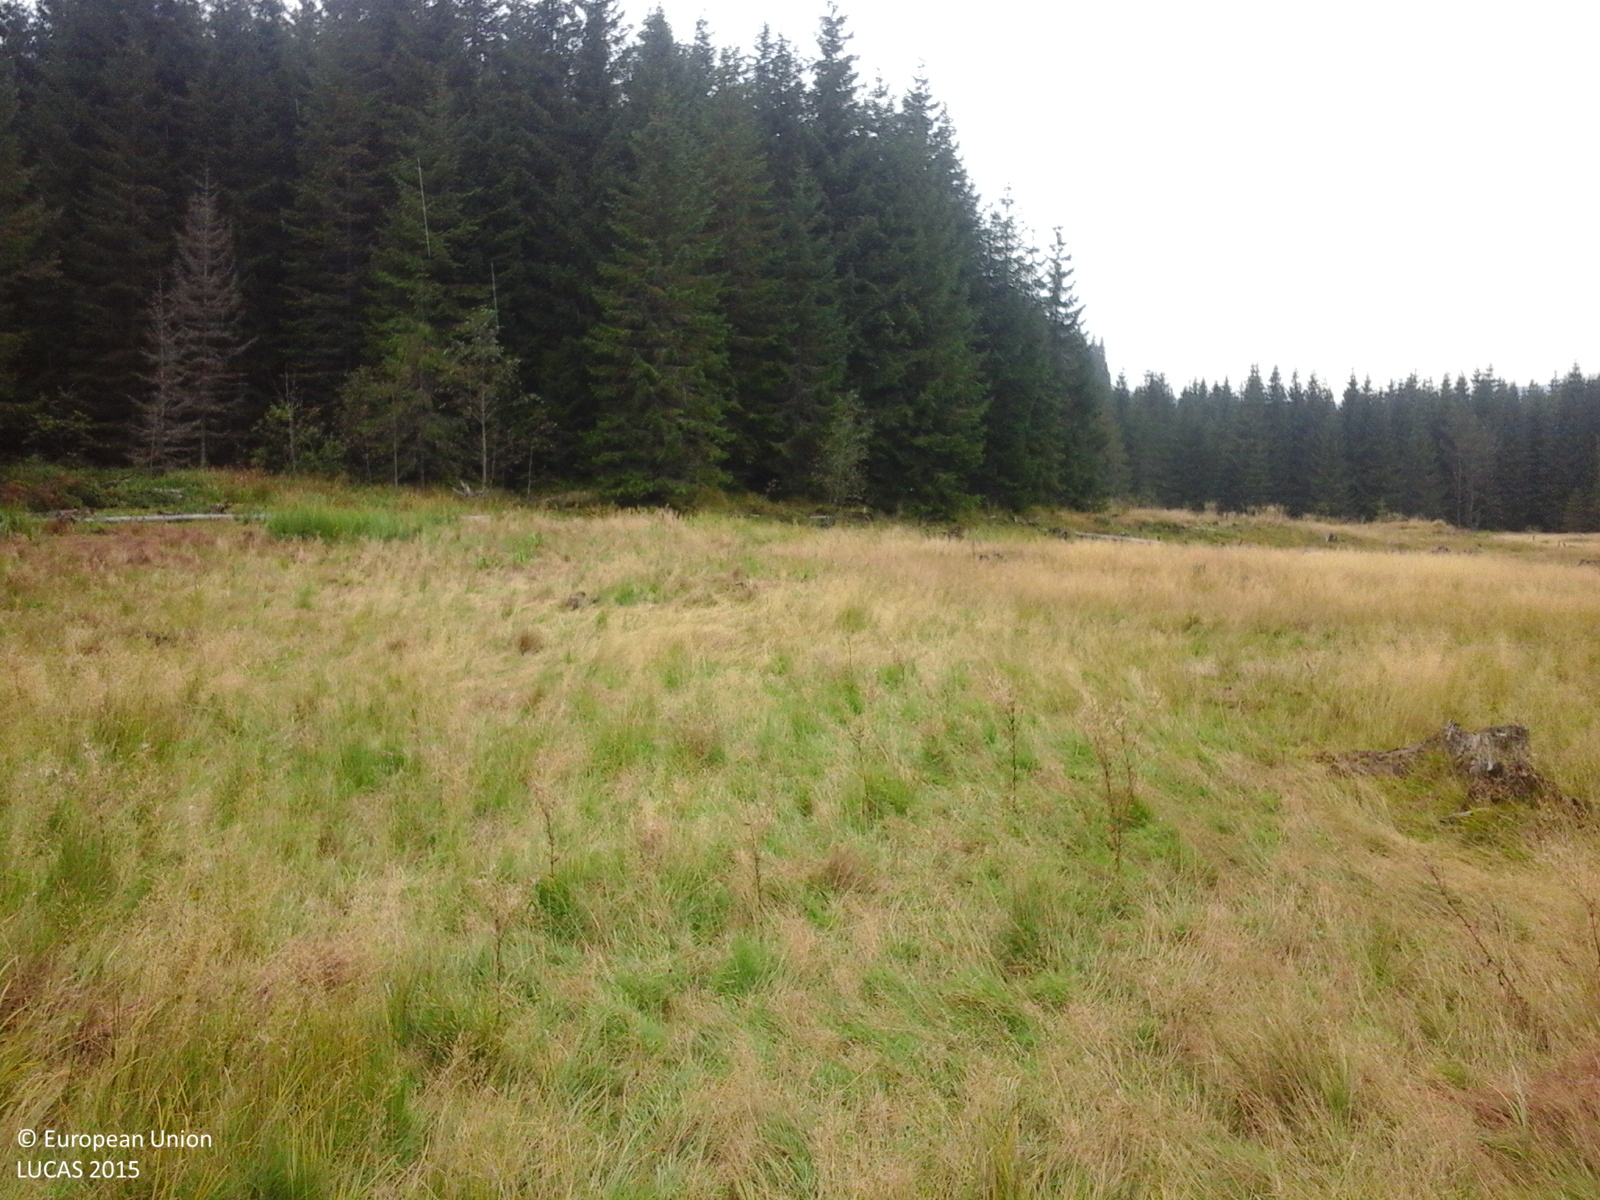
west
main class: Grassland
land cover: Grassland without tree/shrub cover
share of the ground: > 75 %
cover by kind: herbaceous plants 100 %
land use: Agriculture (excluding fallow land and kitchen gardens)
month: September
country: RO
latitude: 45.4312
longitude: 23.6765
